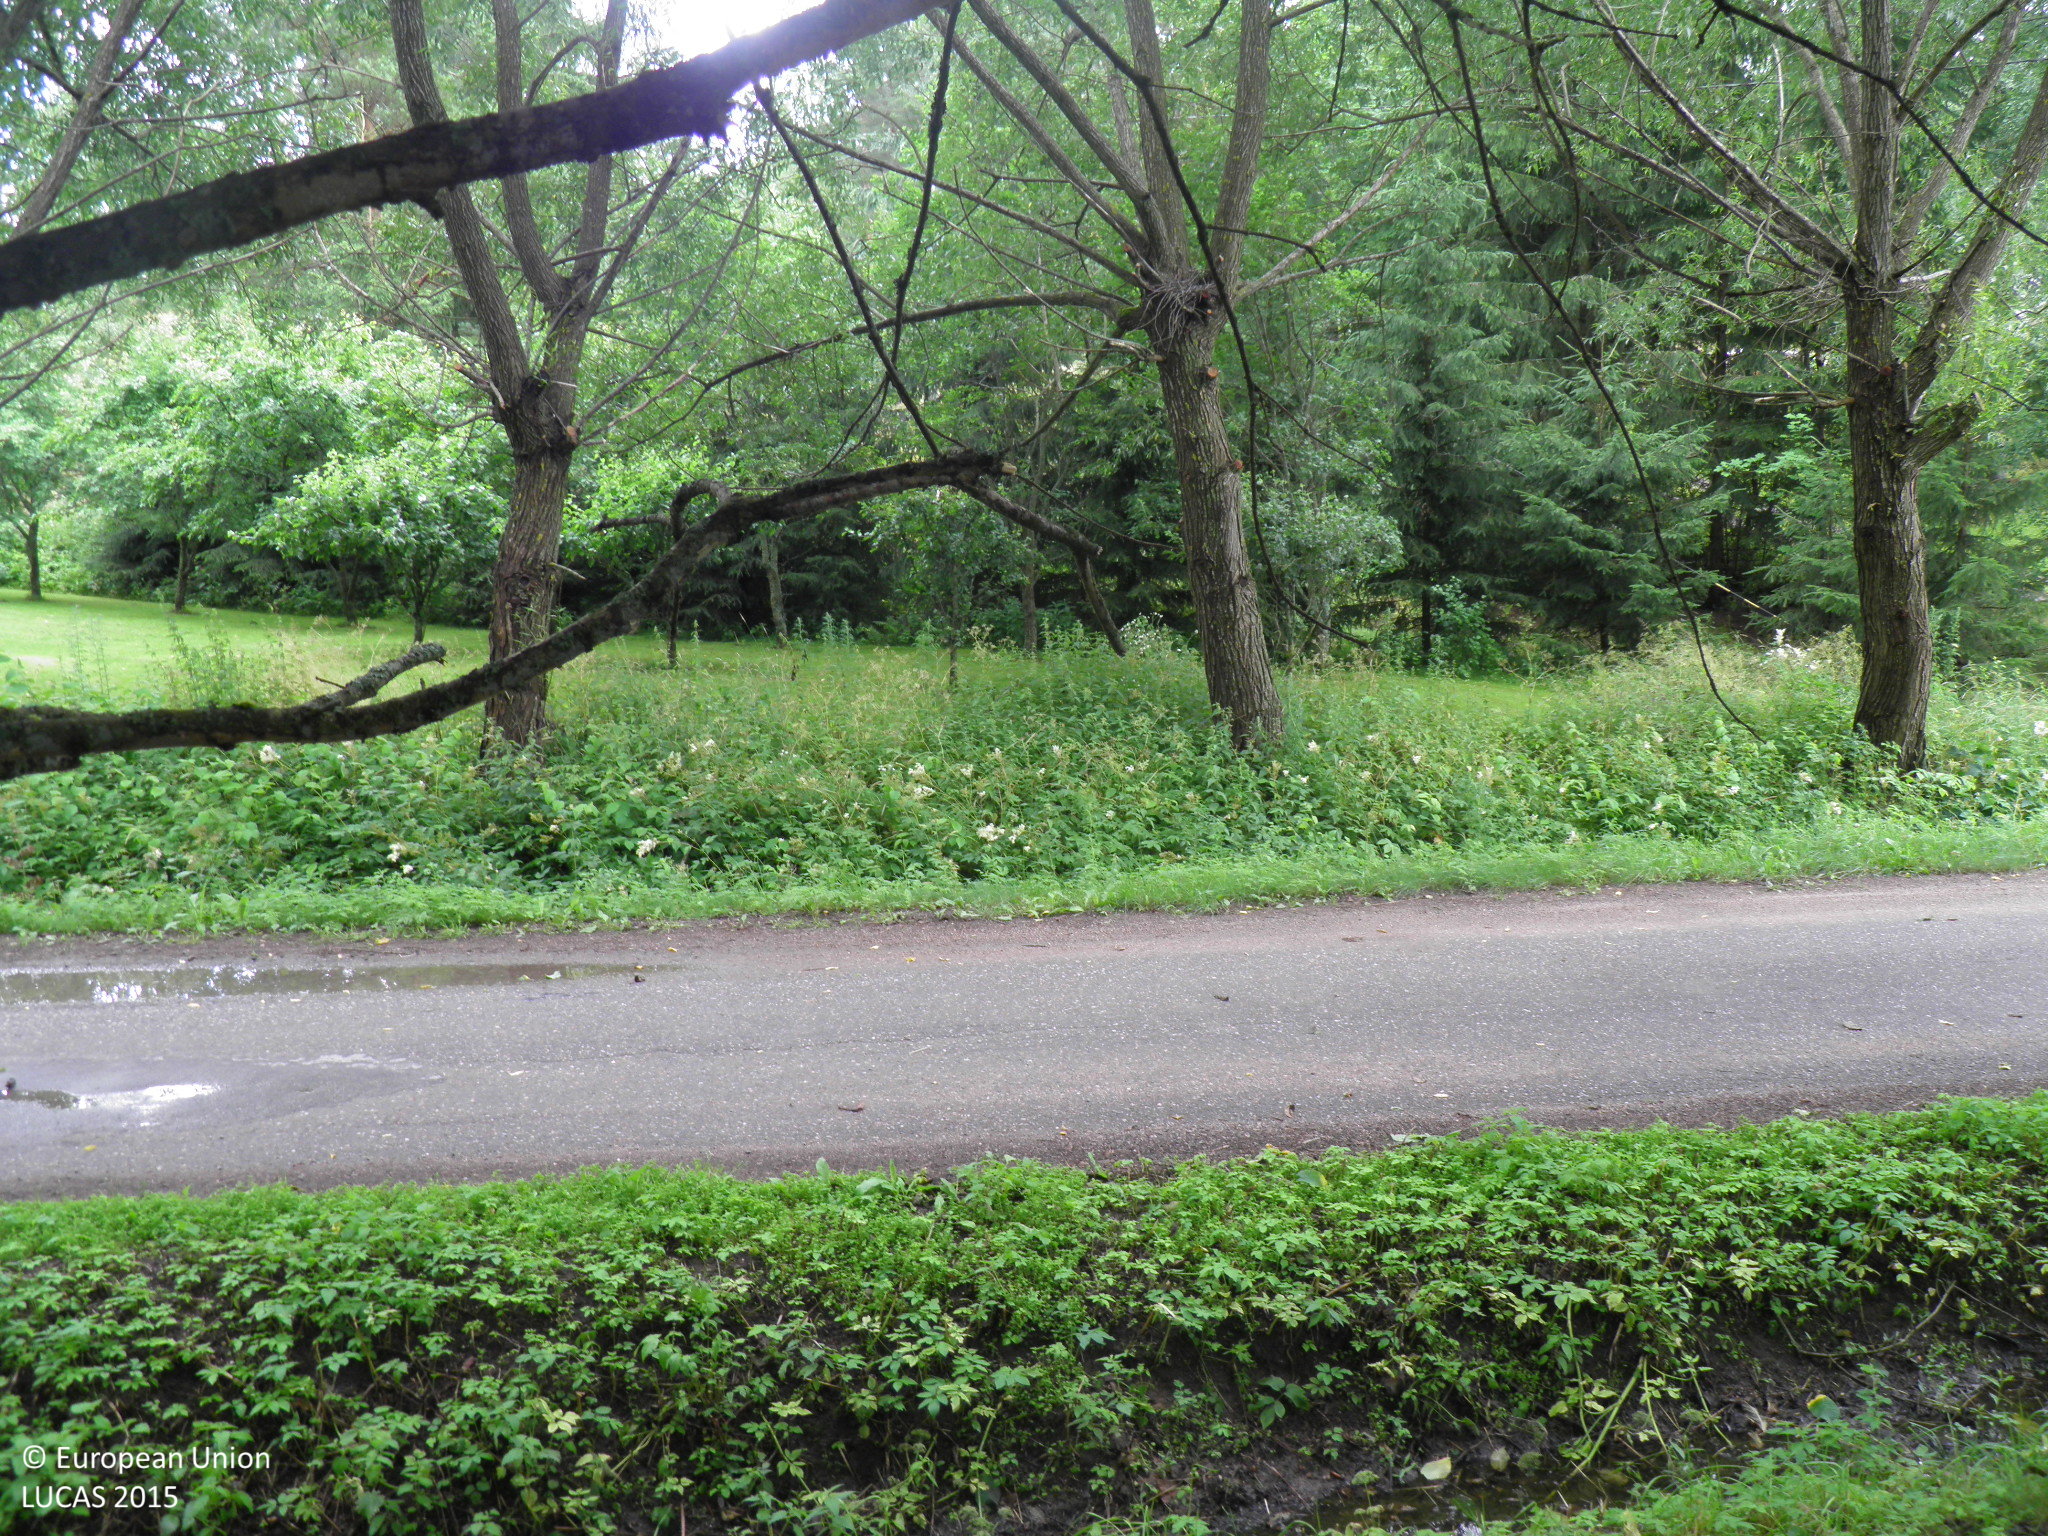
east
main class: Woodland
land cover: Spruce dominated mixed woodland
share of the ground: > 75 %
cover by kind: broadleaved forest trees 50 %, coniferous forest trees 25 %, herbaceous plants 15 %, shrubs 10 %
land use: Residential
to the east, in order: Spruce dominated mixed woodland; Grass margins; Ditches and canals; Paved roads, cycling and walking lanes; Grass margins; Ditches and canals; Other mixed woodland; Pine dominated mixed woodland; Electric lines; Pine dominated mixed woodland; Broadleaved woodland; Pine dominated mixed woodland
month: July
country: FI
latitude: 60.1643
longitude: 22.5608
